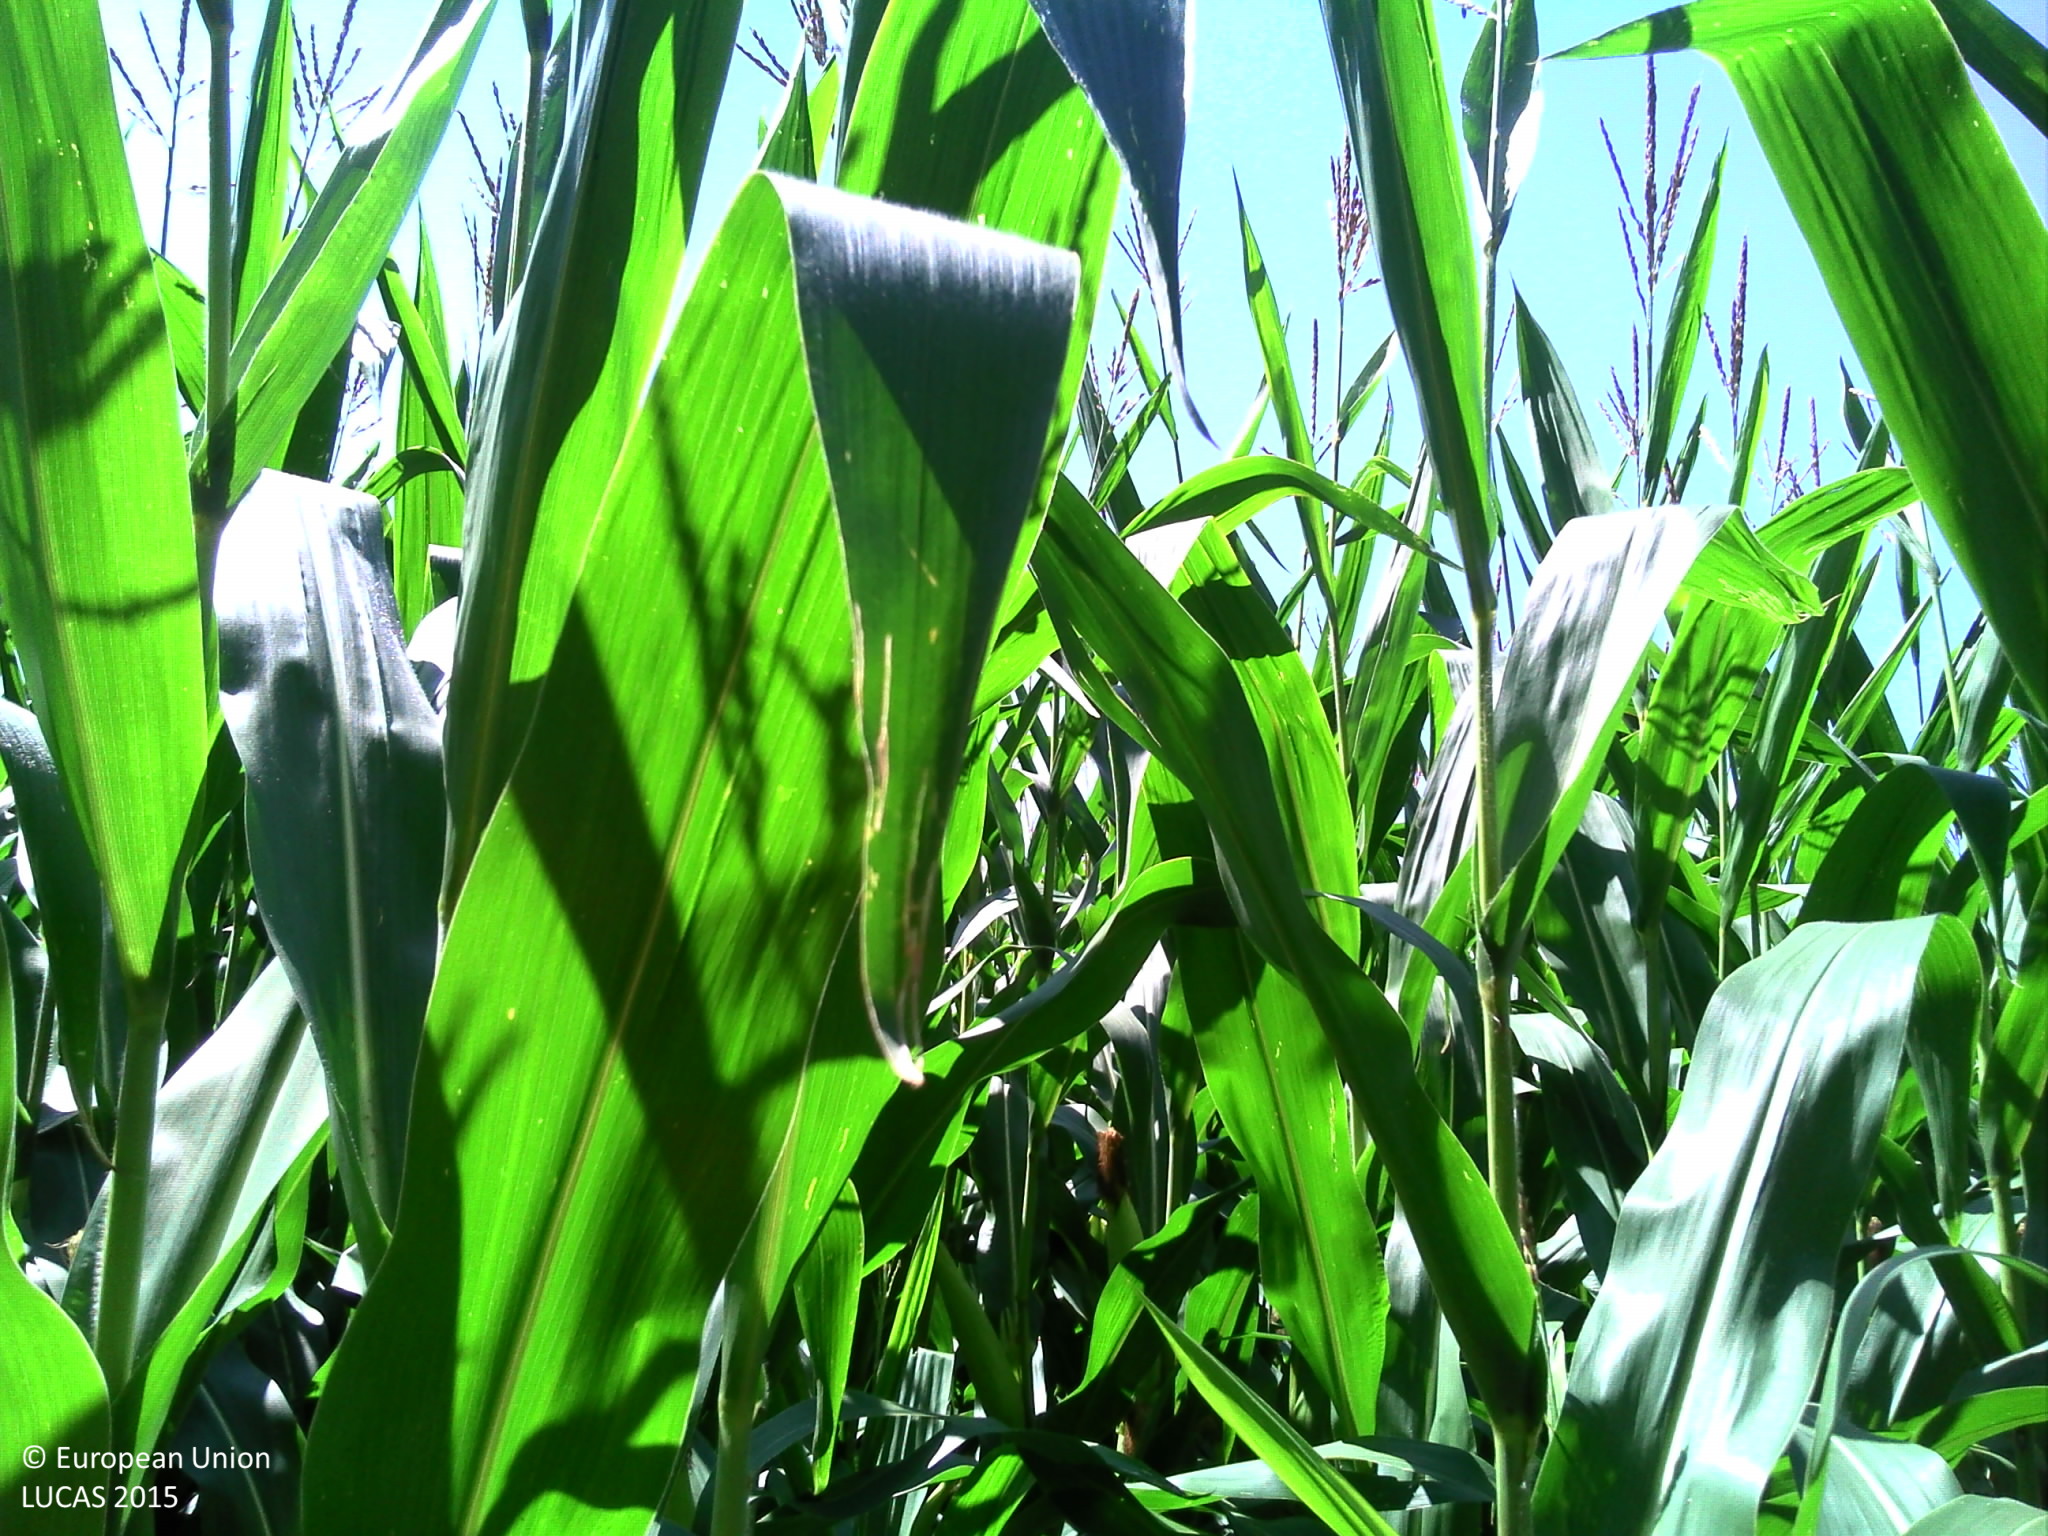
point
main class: Cropland
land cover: Maize
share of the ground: > 75 %
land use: Agriculture (excluding fallow land and kitchen gardens)
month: August
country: FR
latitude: 48.8178
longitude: 8.0259
